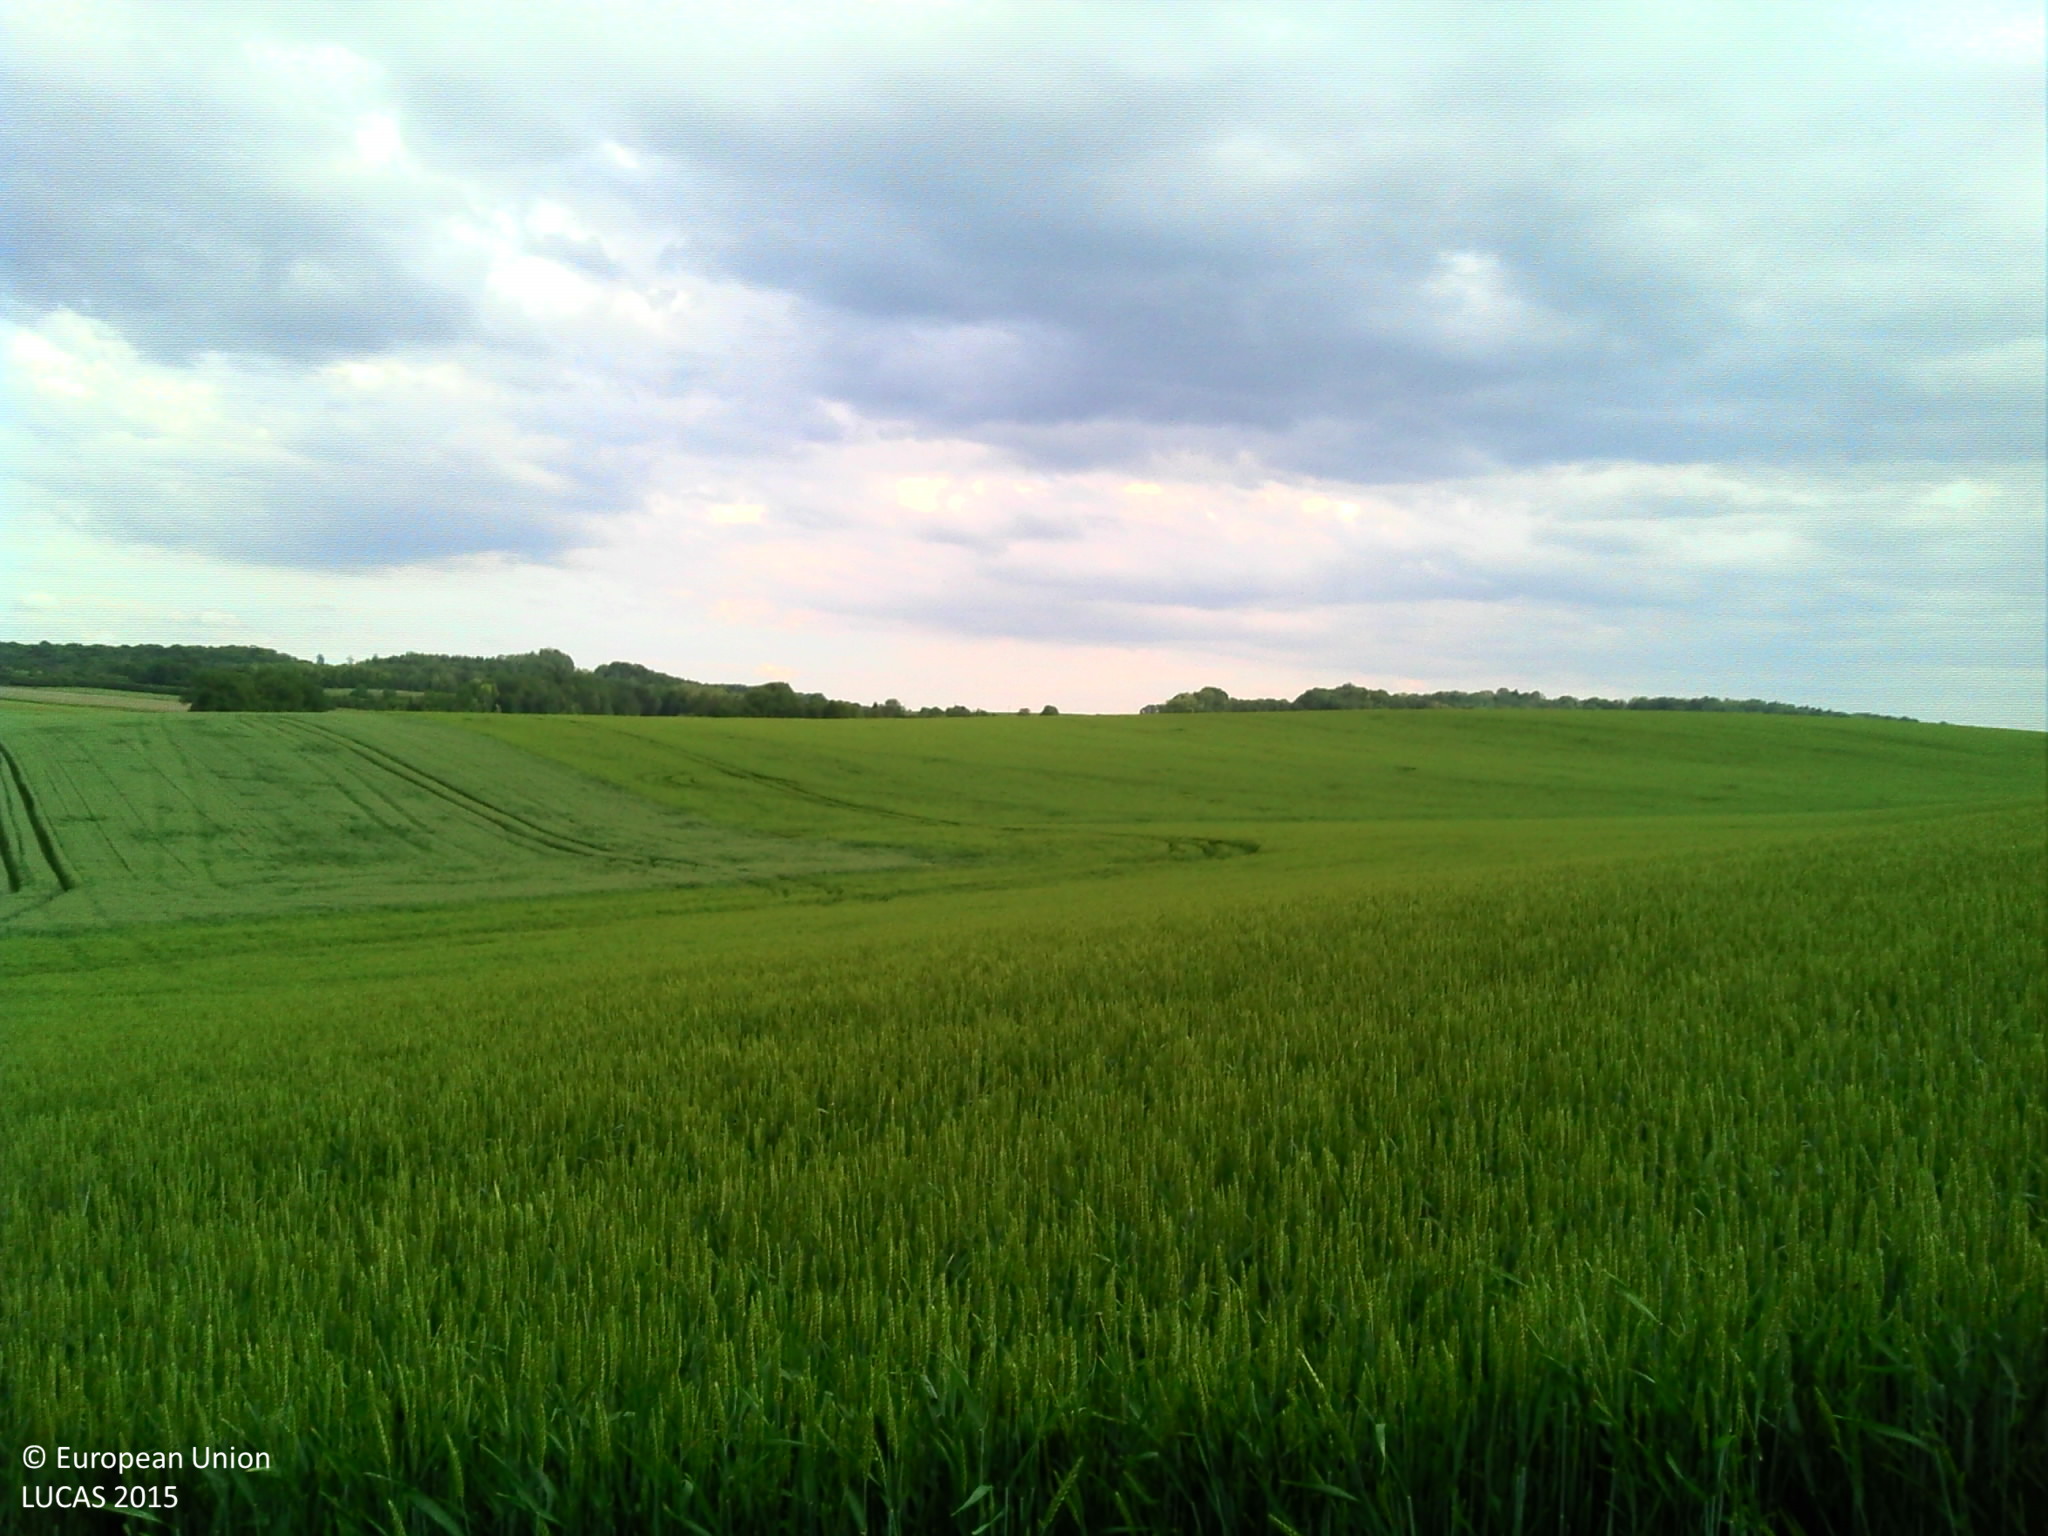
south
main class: Cropland
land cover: Common wheat
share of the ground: > 75 %
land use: Agriculture (excluding fallow land and kitchen gardens)
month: May
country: FR
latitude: 47.8818
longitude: 6.0292
